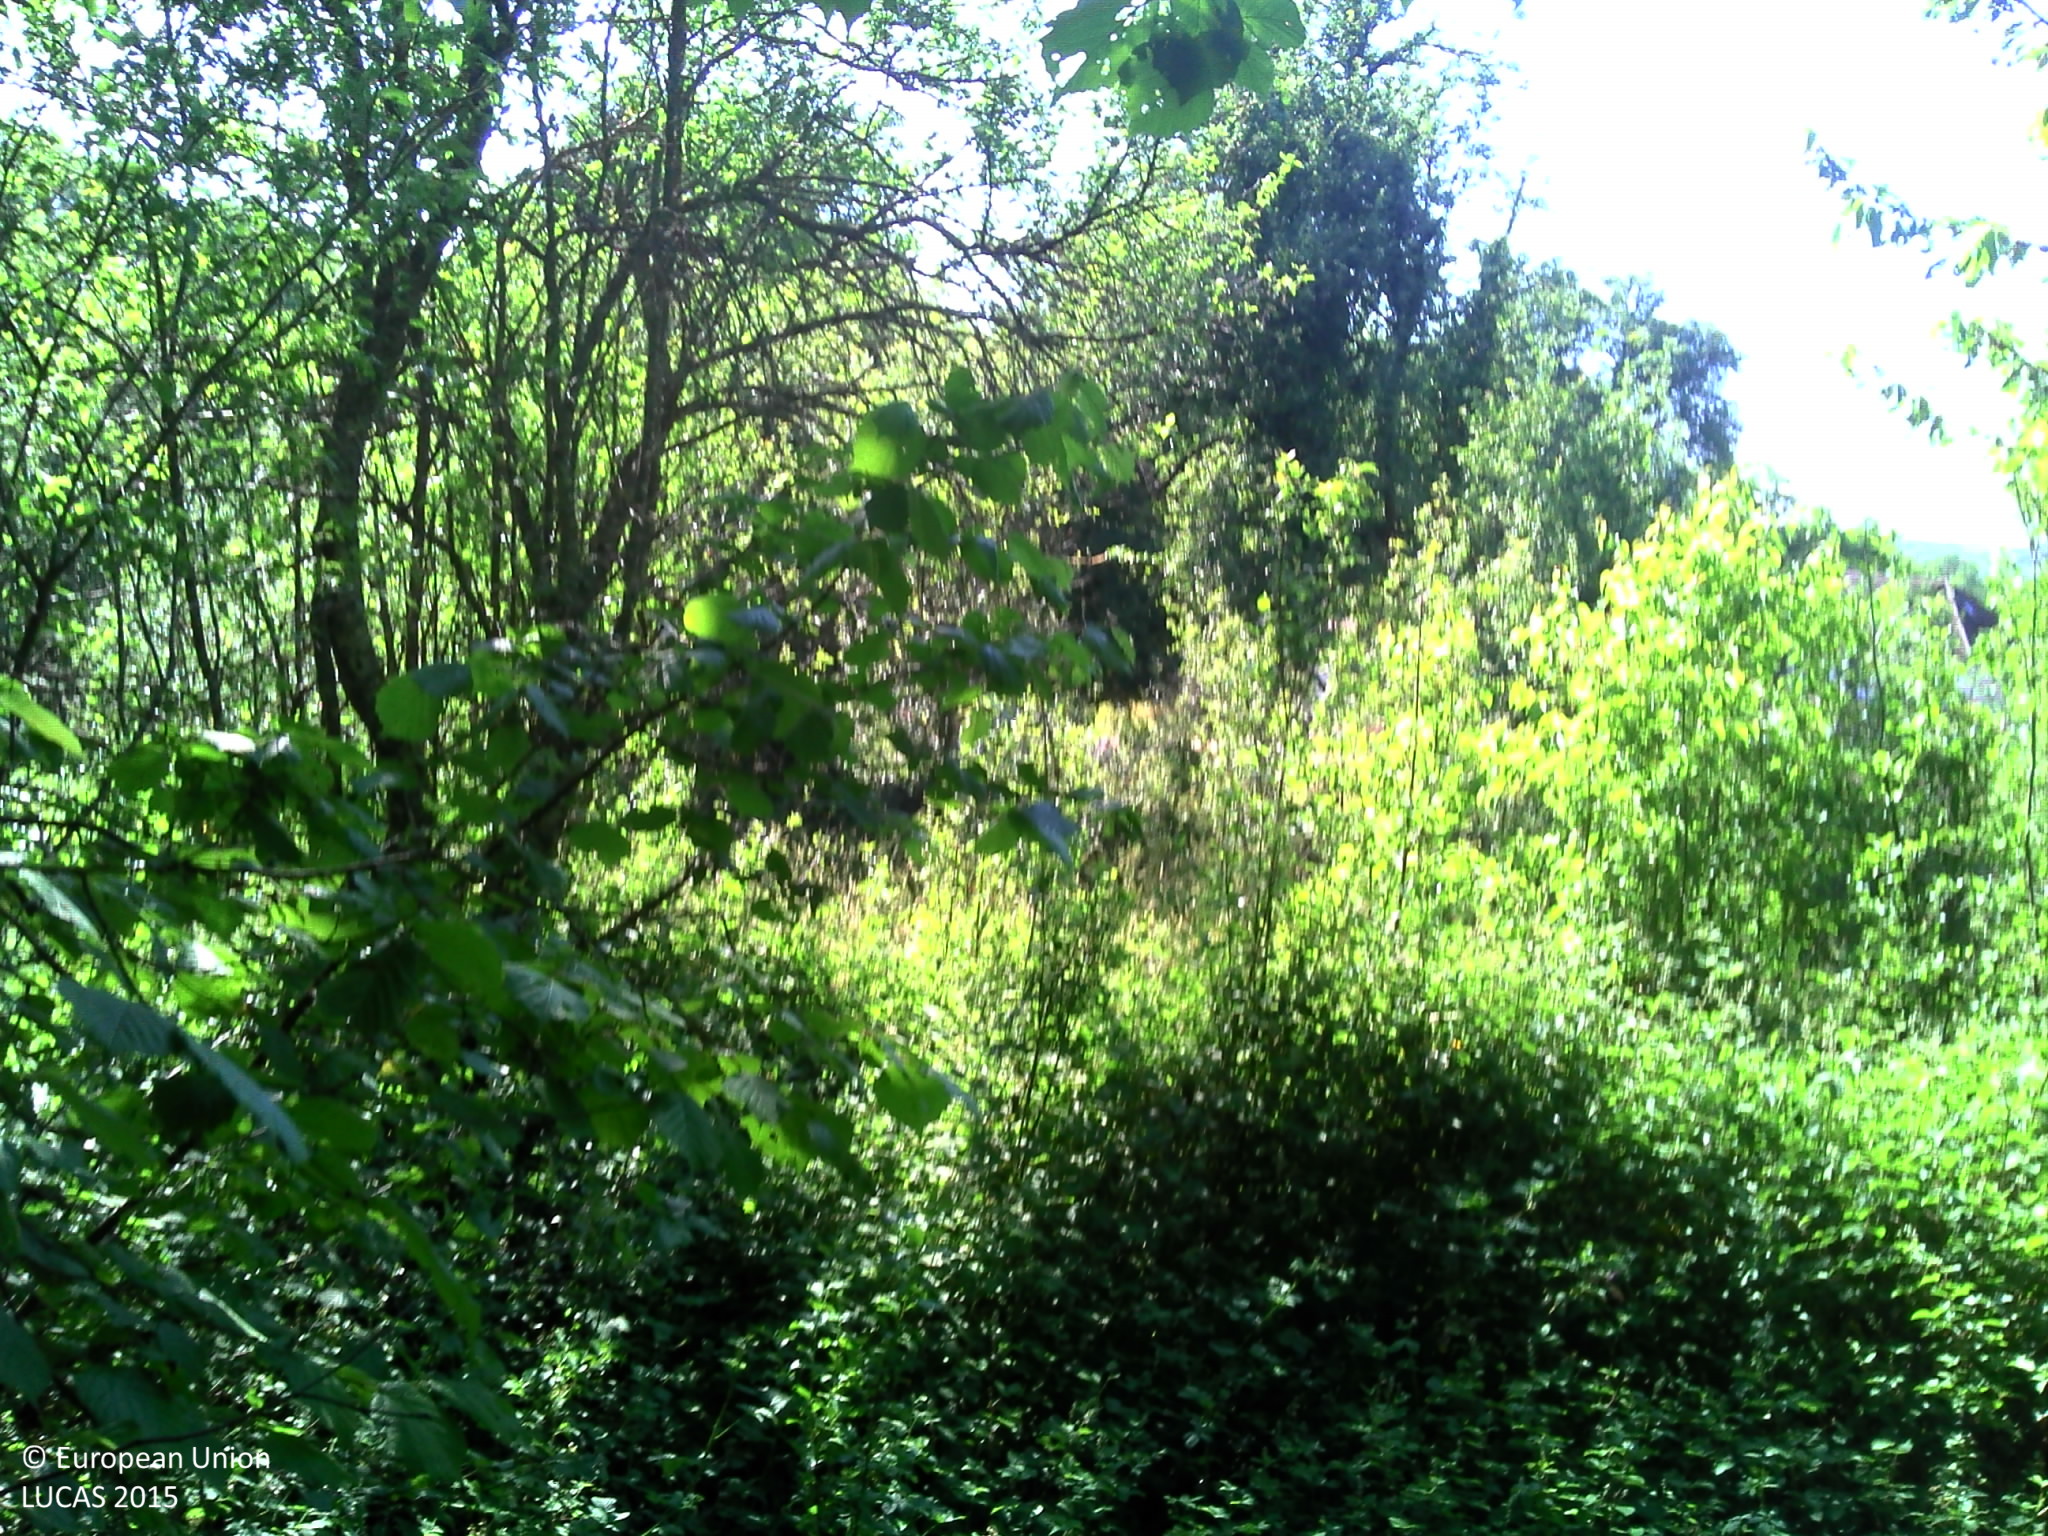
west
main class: Woodland
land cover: Broadleaved woodland
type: beech forest
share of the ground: > 75 %
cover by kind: broadleaved forest trees 70 %, herbaceous plants 30 %
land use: Forestry
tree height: > 5 m
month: June
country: FR
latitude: 47.6548
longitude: 6.2333
